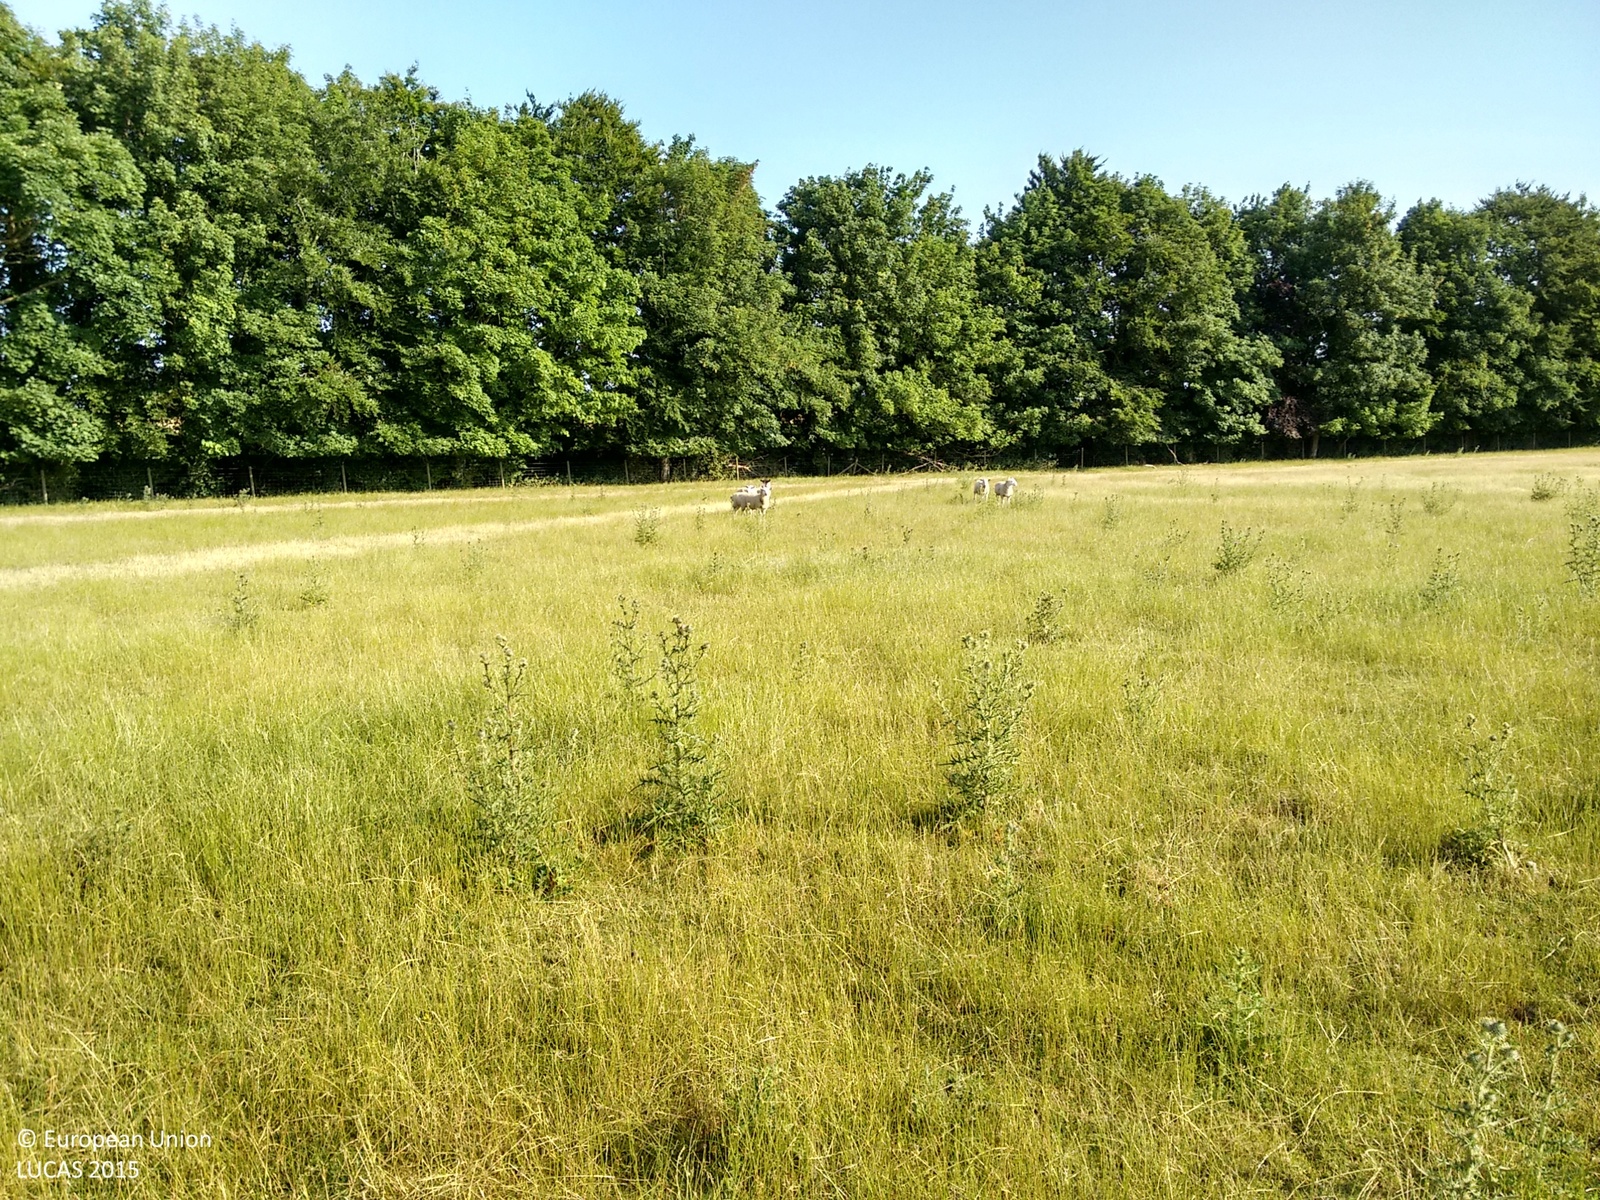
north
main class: Grassland
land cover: Grassland without tree/shrub cover
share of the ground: > 75 %
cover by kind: herbaceous plants 100 %
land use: Agriculture (excluding fallow land and kitchen gardens)
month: July
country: GB
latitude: 51.9688
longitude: -1.2409
